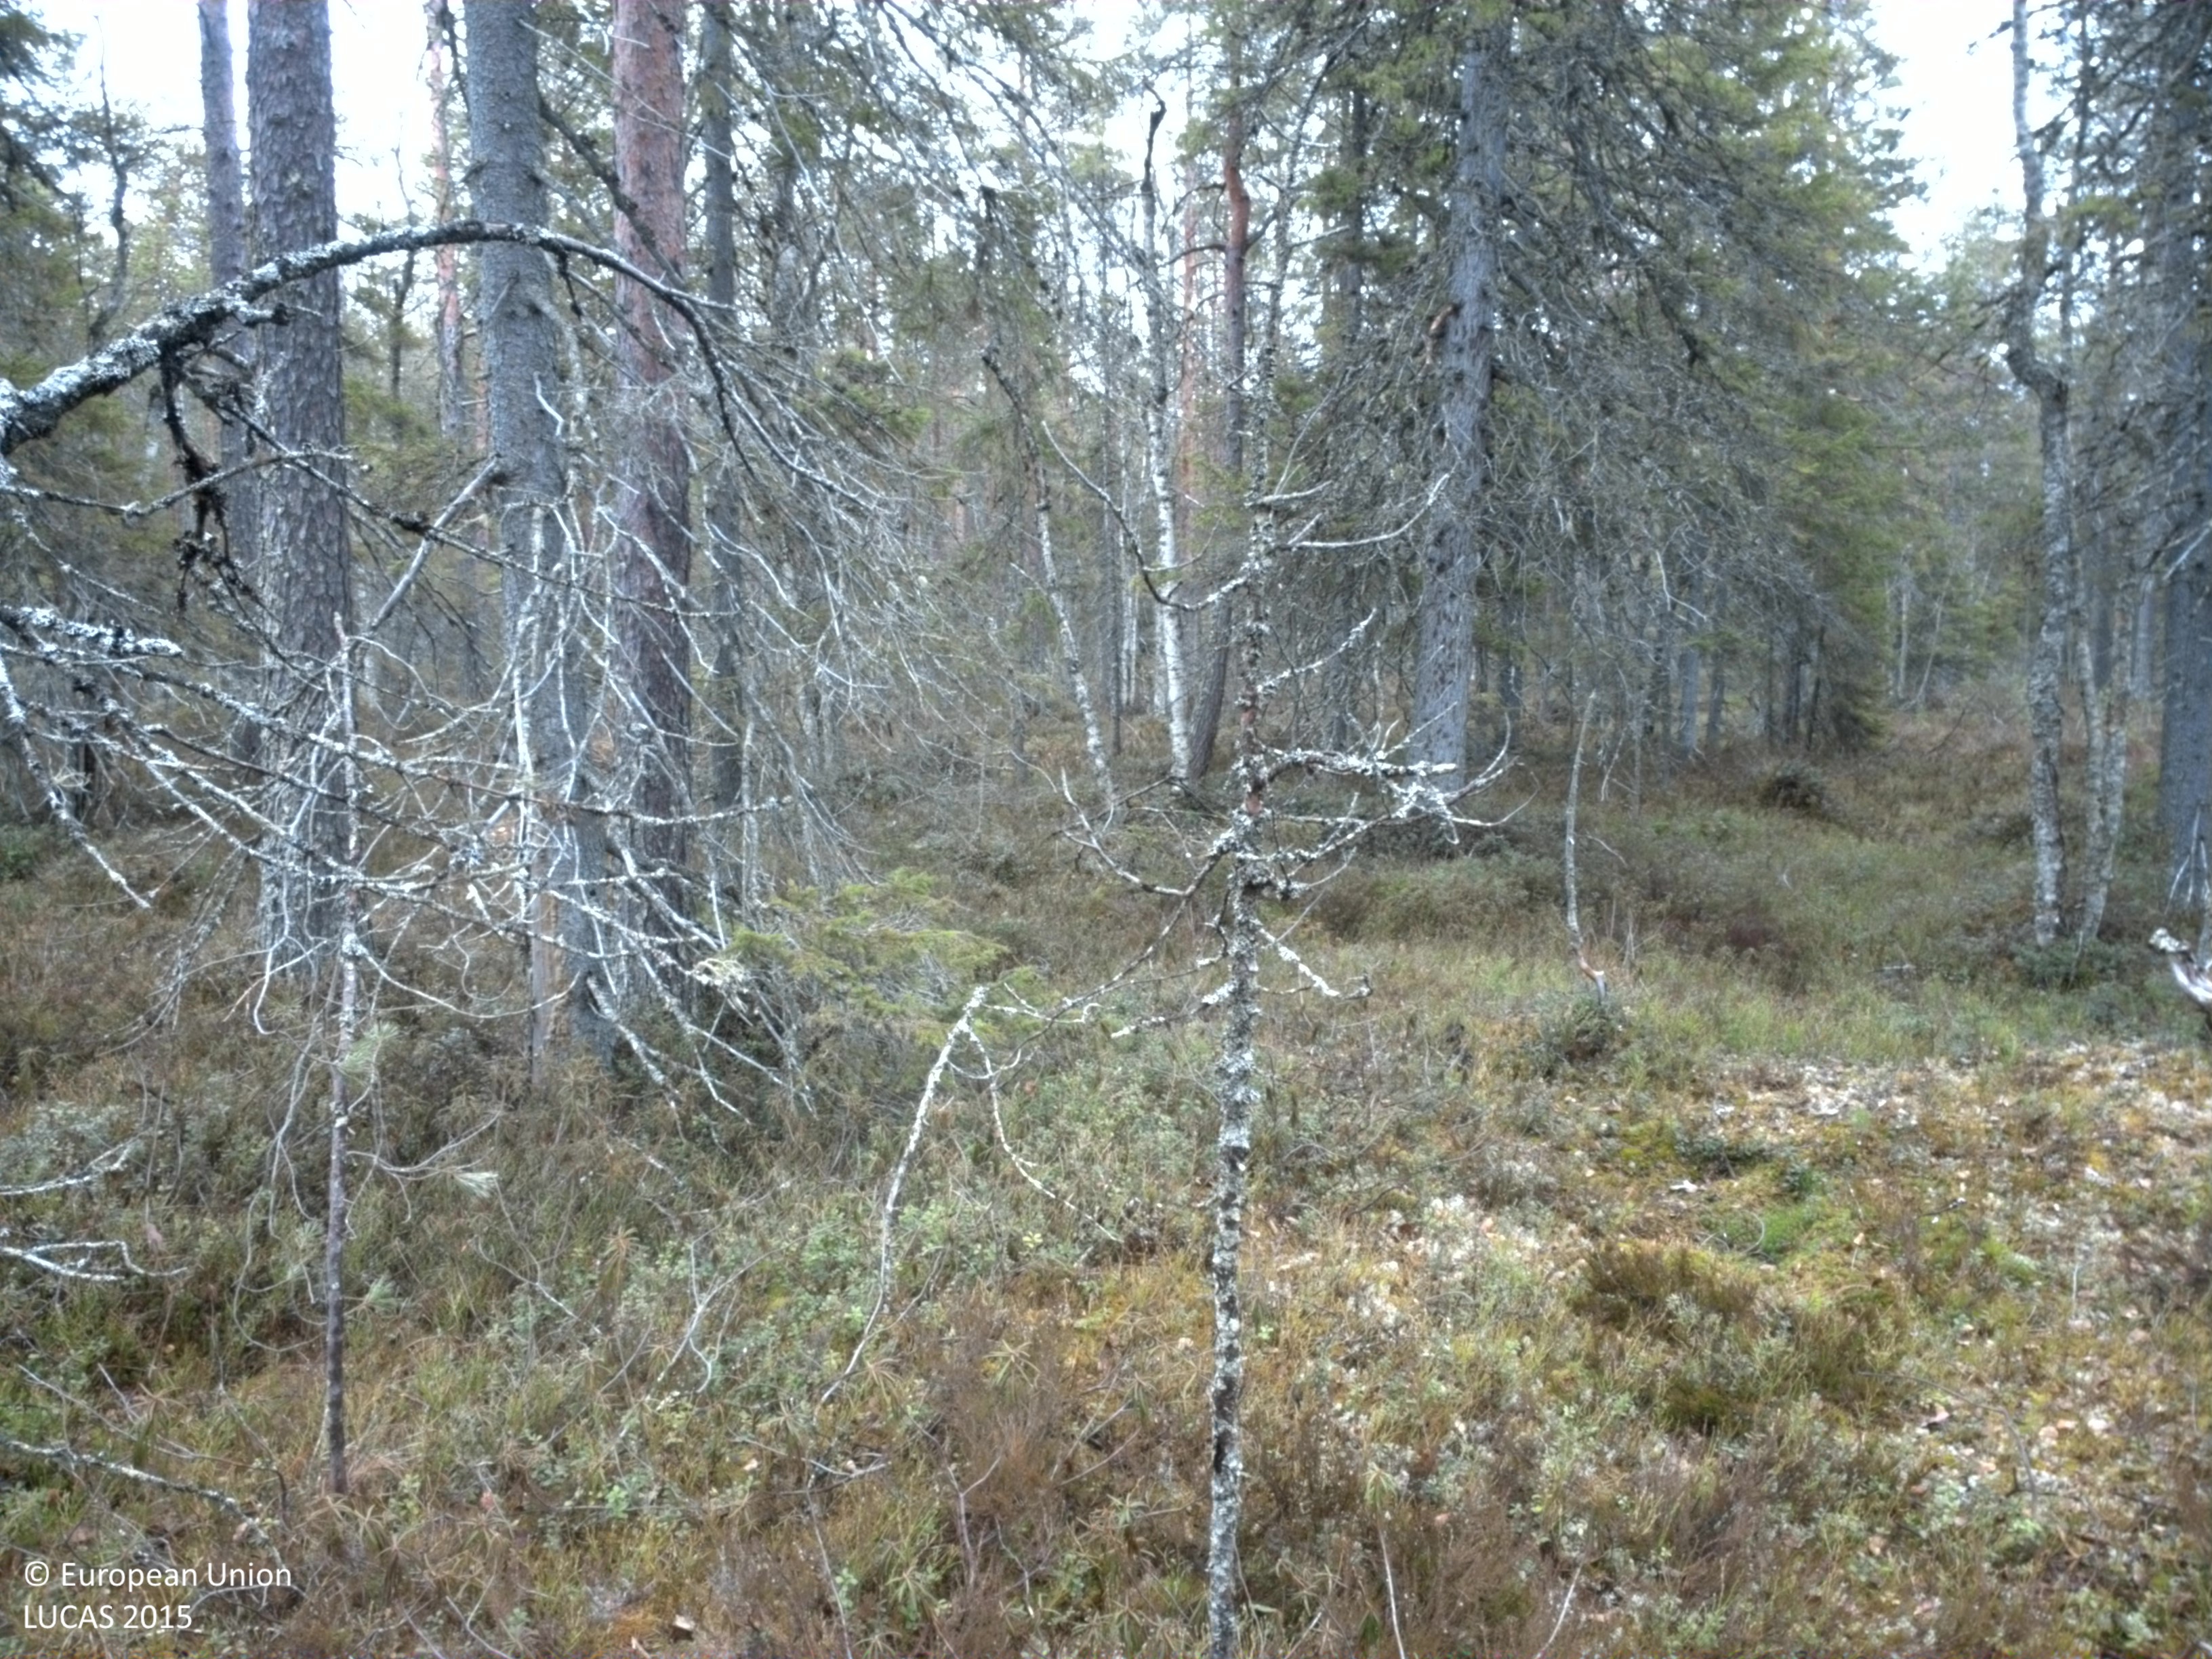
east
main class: Woodland
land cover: Other coniferous woodland
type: boreal forest
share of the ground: > 75 %
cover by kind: coniferous forest trees 75 %, shrubs 15 %, broadleaved forest trees 5 %, lichens and mosses 5 %
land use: Forestry
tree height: > 5 m
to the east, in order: Other coniferous woodland; Pine dominated coniferous woodland; Other mixed woodland; Pine dominated coniferous woodland
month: May
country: SE
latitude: 65.8680
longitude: 22.9399
